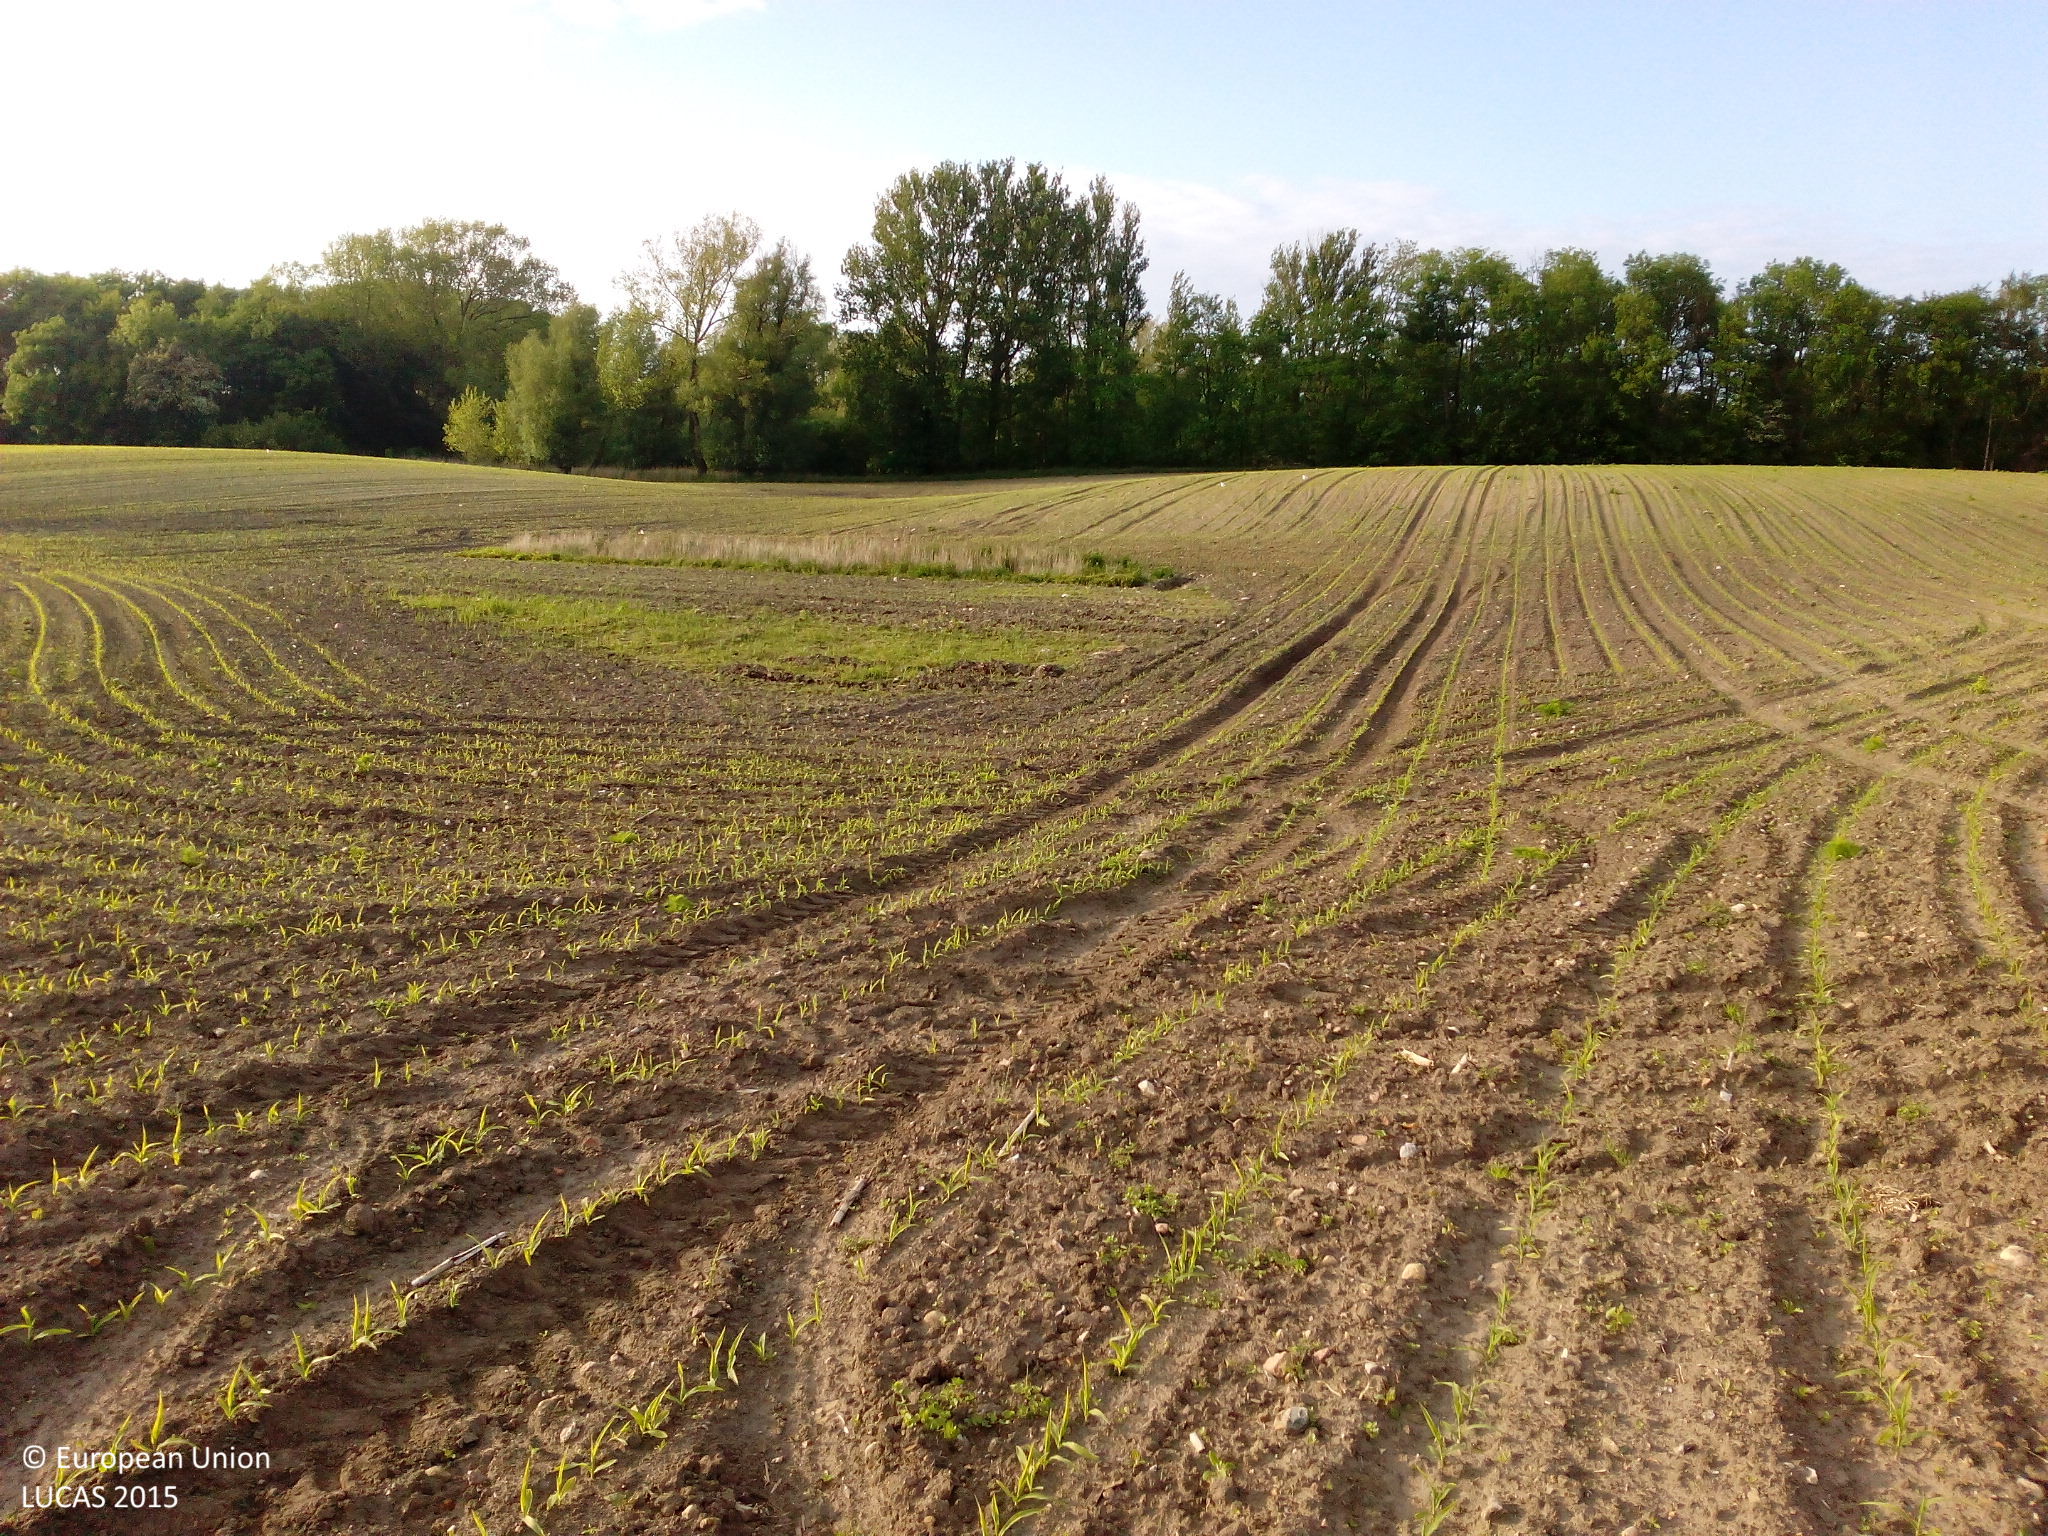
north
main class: Cropland
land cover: Maize
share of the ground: < 10 %
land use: Agriculture (excluding fallow land and kitchen gardens)
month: June
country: DK
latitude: 55.5210
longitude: 10.6488
